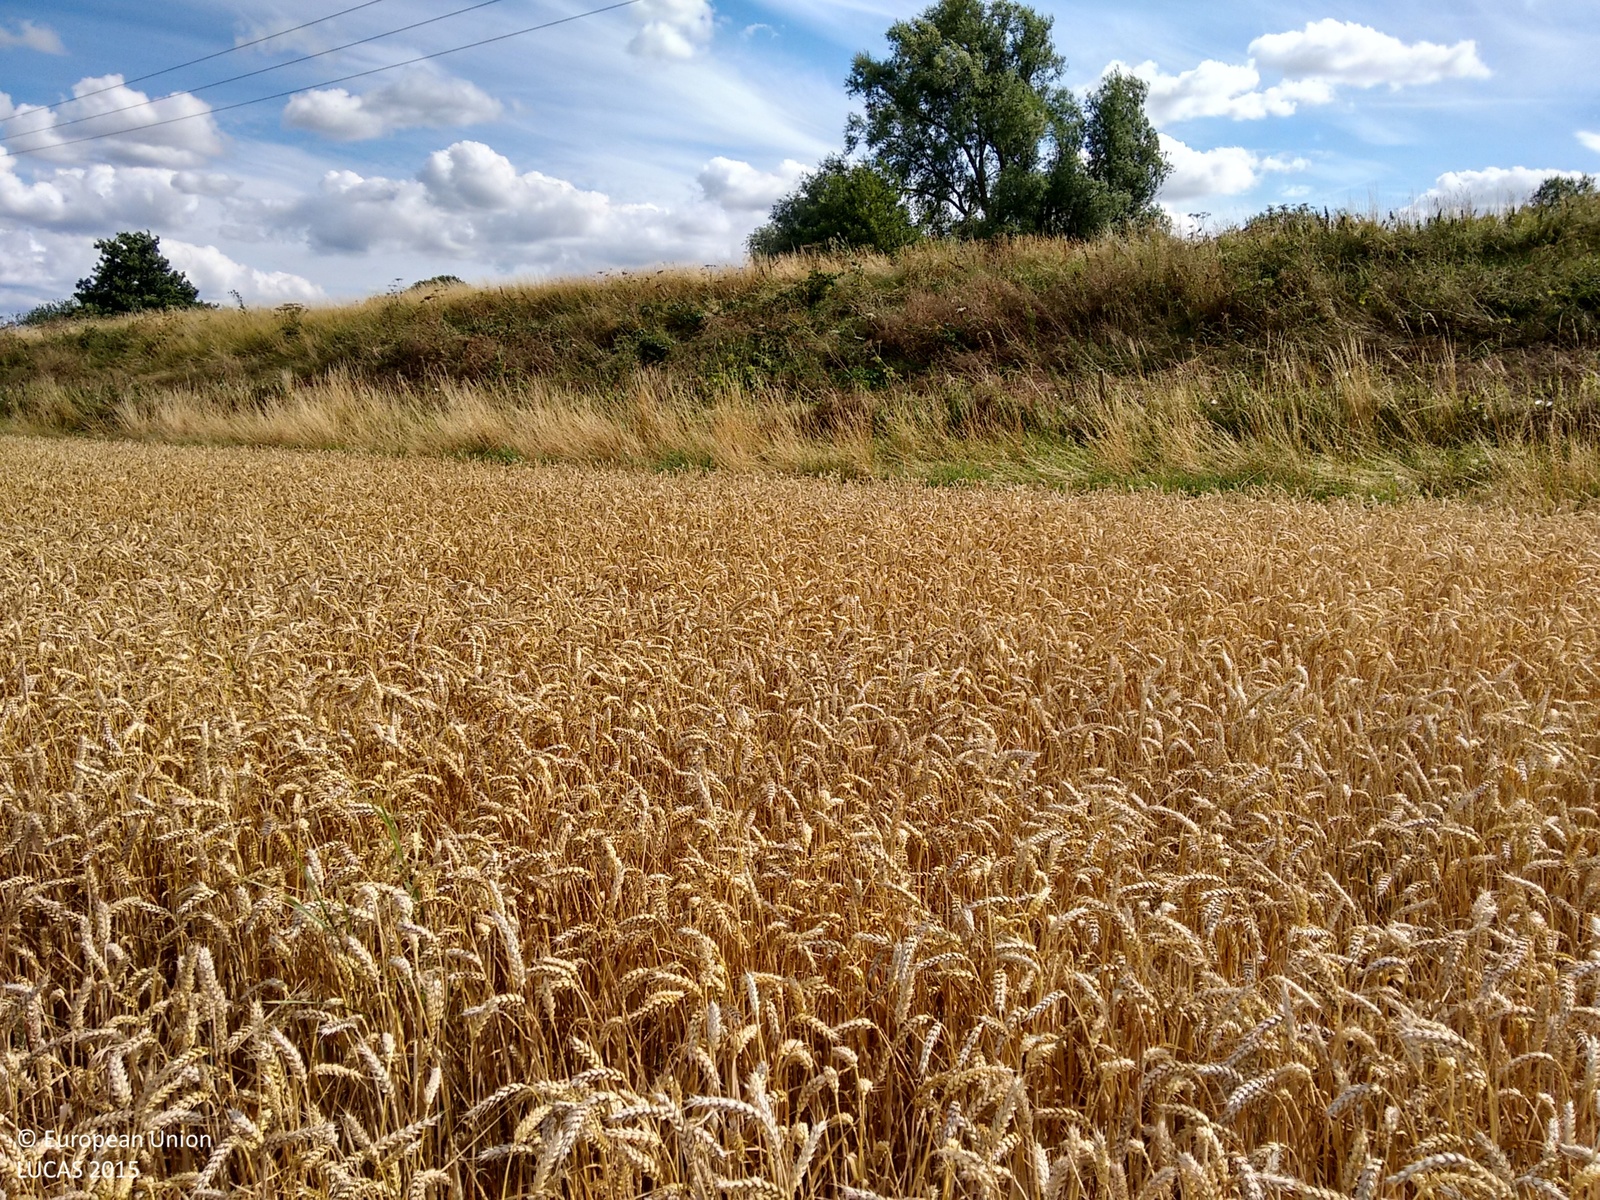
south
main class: Cropland
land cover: Common wheat
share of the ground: > 75 %
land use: Agriculture (excluding fallow land and kitchen gardens)
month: August
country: GB
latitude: 52.4446
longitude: 0.4532
